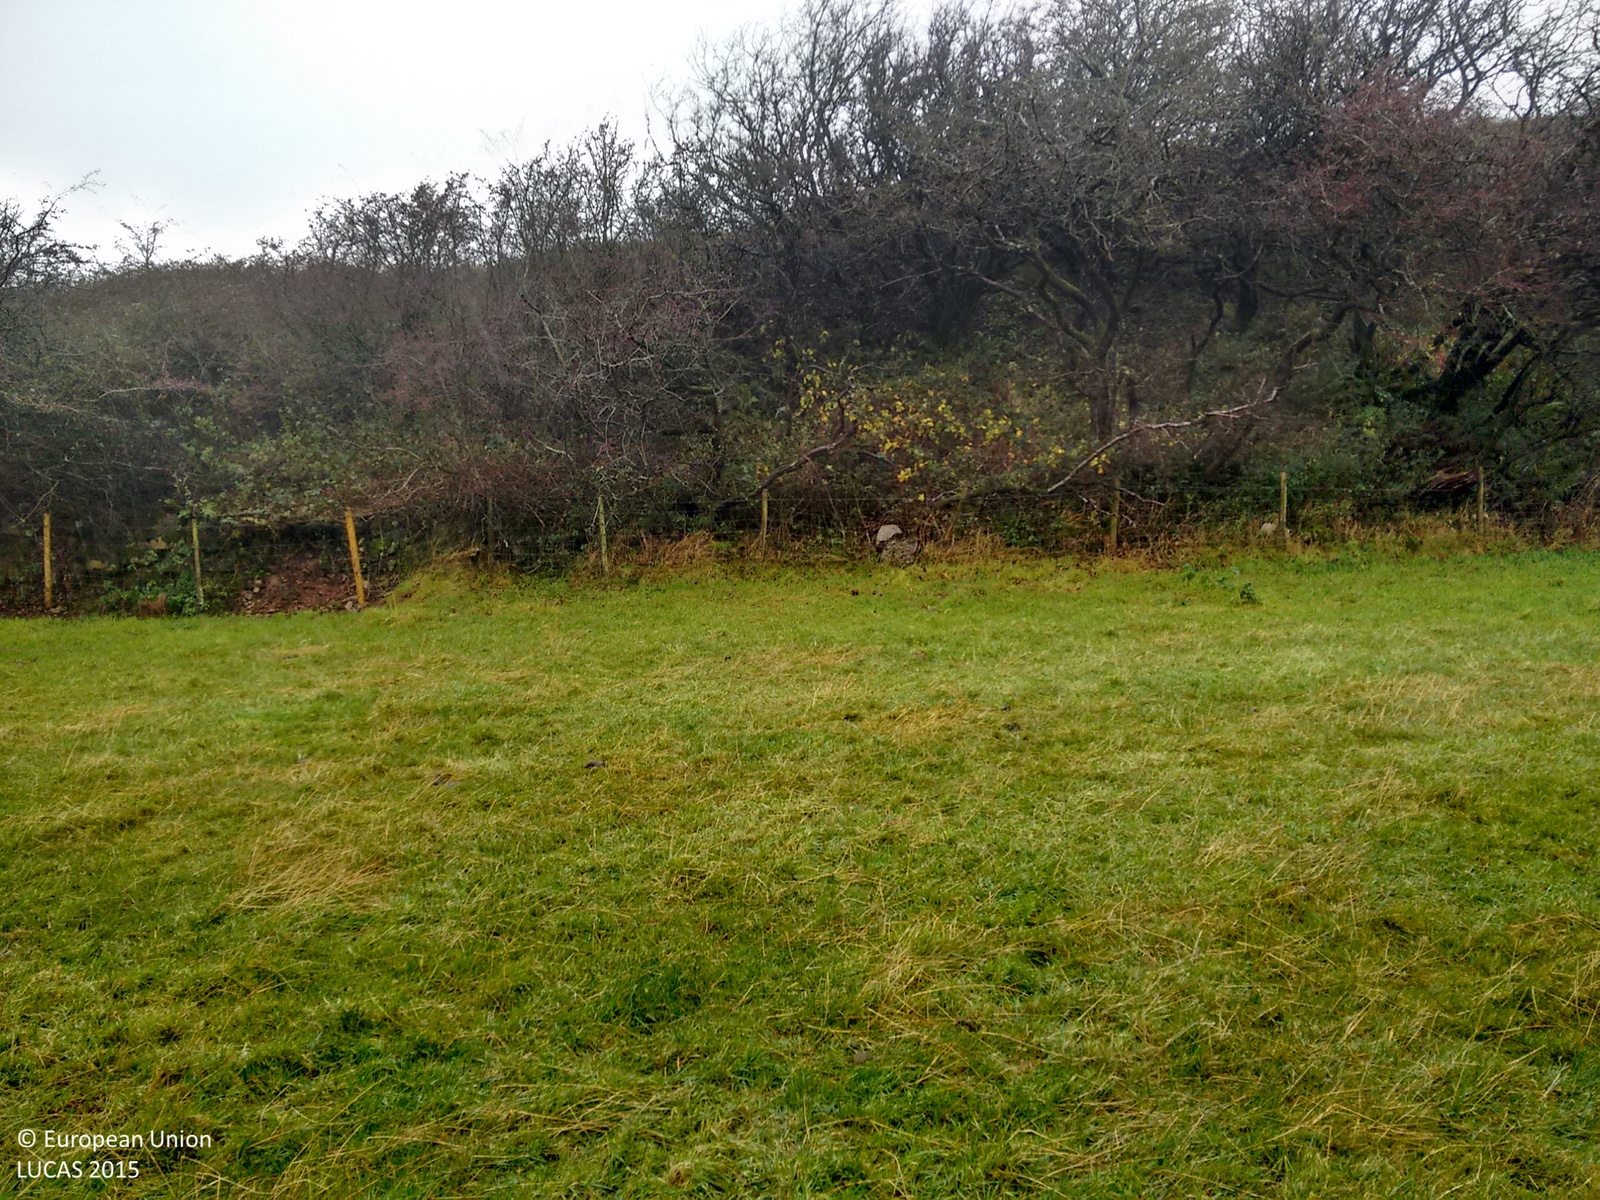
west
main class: Grassland
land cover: Grassland without tree/shrub cover
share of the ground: > 75 %
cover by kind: herbaceous plants 100 %
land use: Agriculture (excluding fallow land and kitchen gardens)
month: November
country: GB
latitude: 54.5442
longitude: -3.4521
